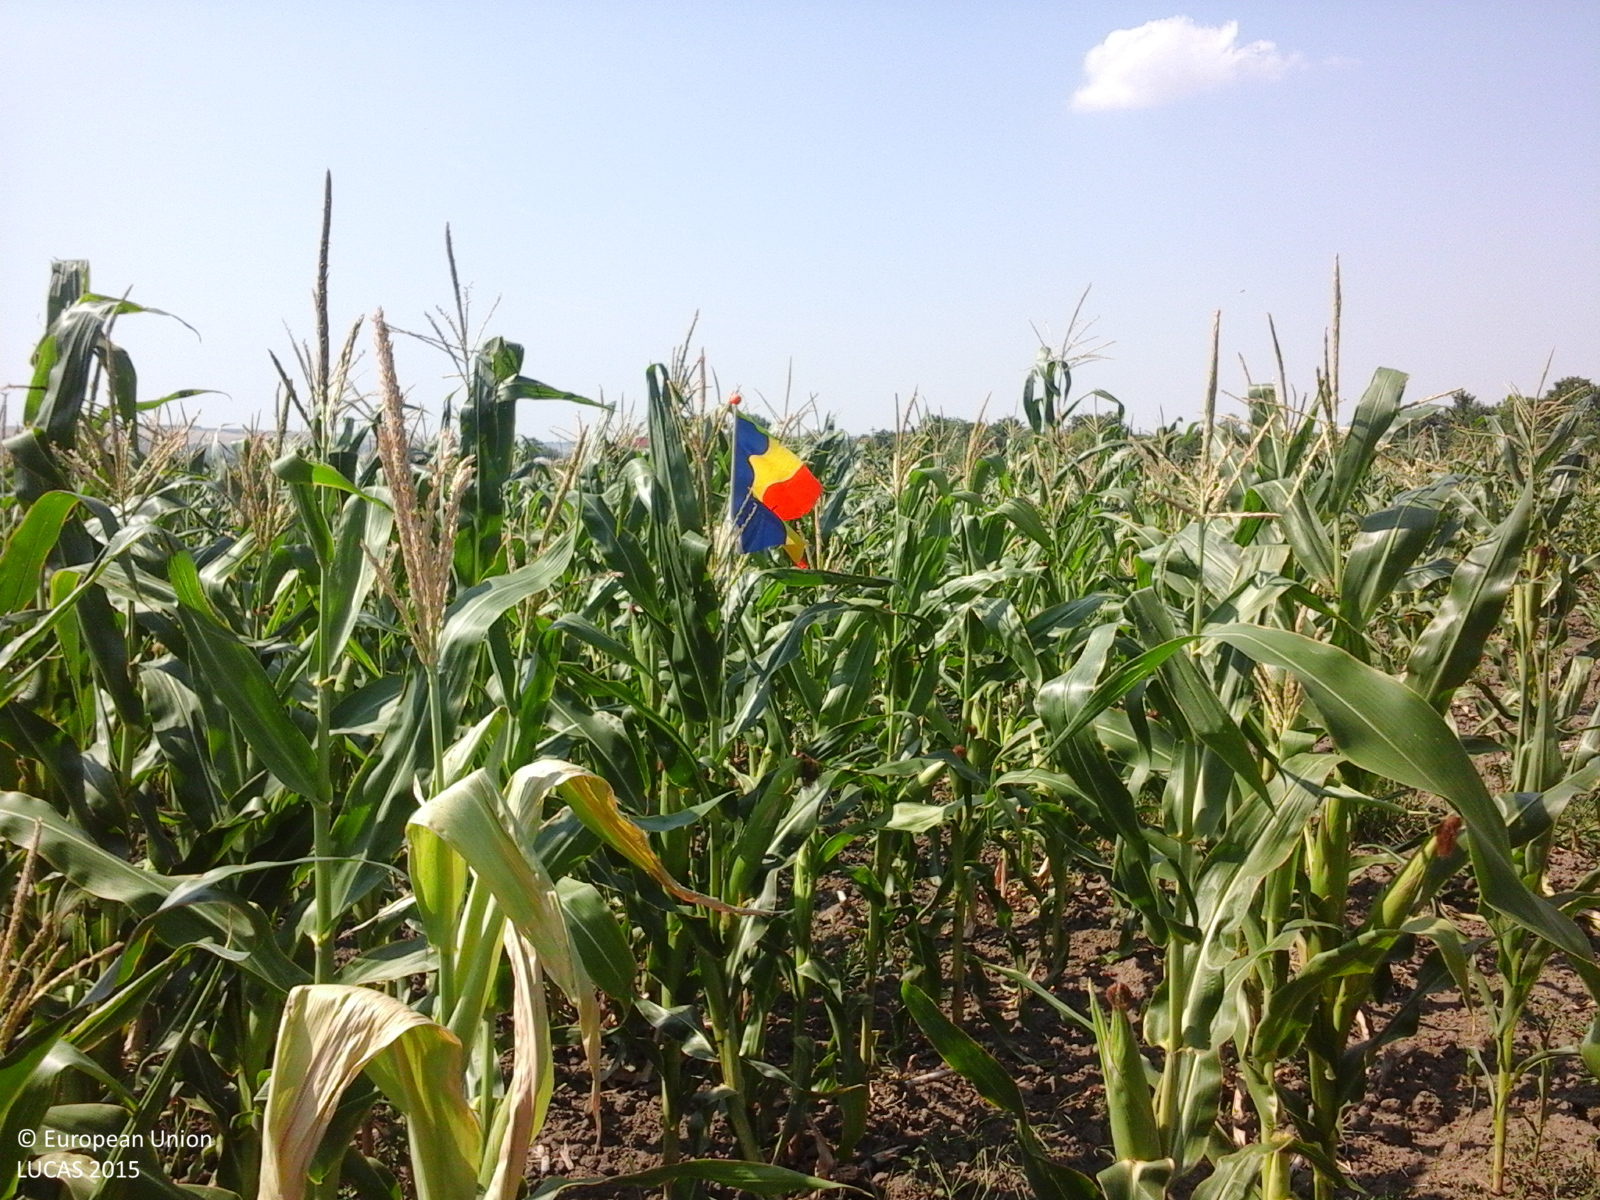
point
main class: Cropland
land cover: Maize
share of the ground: > 75 %
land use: Agriculture (excluding fallow land and kitchen gardens)
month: July
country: RO
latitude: 46.0031
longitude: 27.4741
